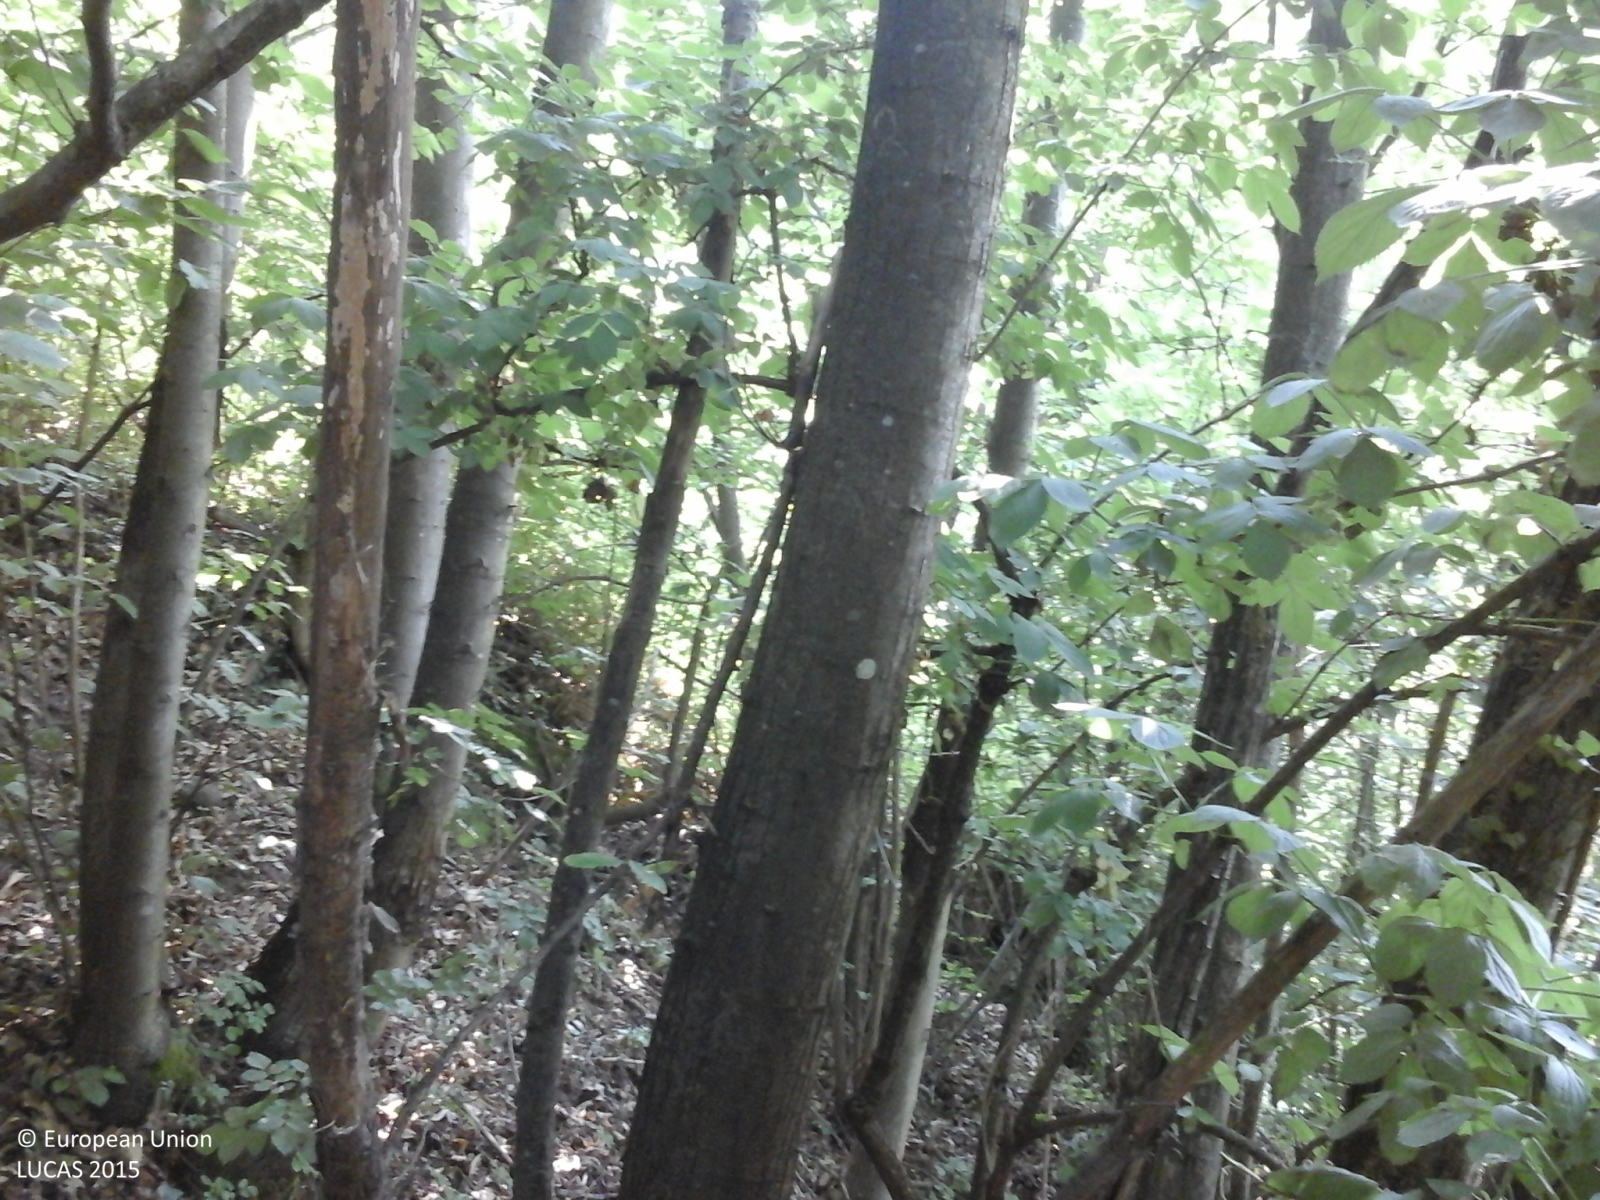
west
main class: Woodland
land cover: Broadleaved woodland
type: thermophilous deciduous forest
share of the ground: > 75 %
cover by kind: broadleaved forest trees 95 %, shrubs 5 %
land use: Forestry
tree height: > 5 m
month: June
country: IT
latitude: 44.5919
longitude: 8.4790
